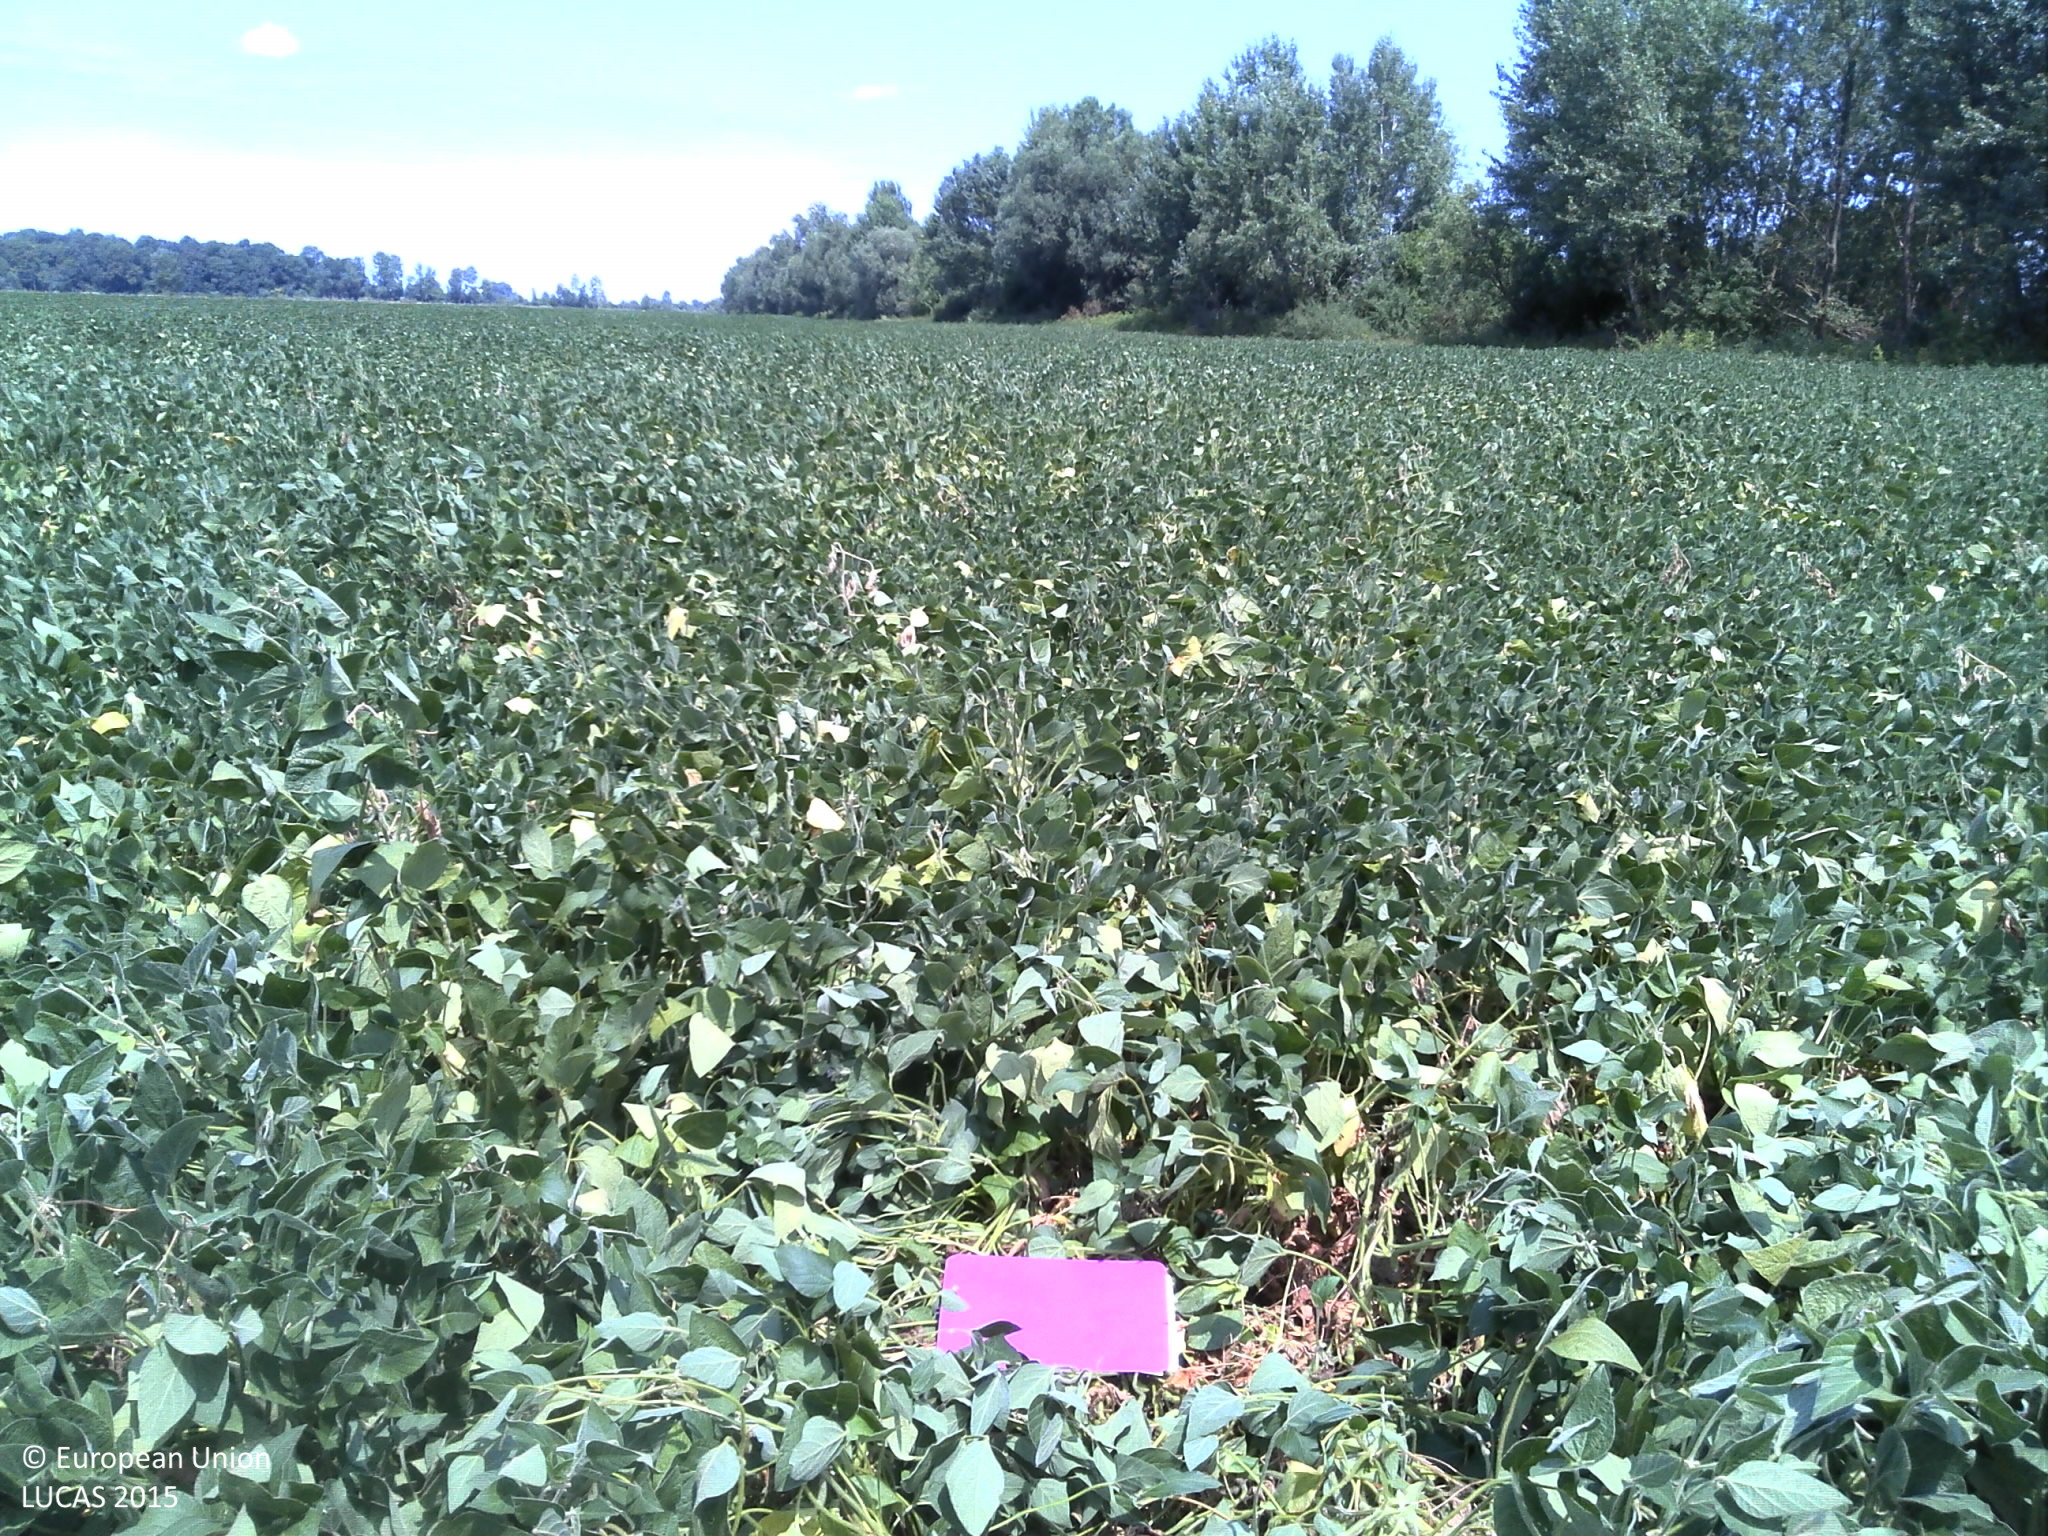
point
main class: Cropland
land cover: Soya
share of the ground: > 75 %
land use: Agriculture (excluding fallow land and kitchen gardens)
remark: Tilled/Sowed
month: July
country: HR
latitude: 44.9052
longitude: 18.9605
